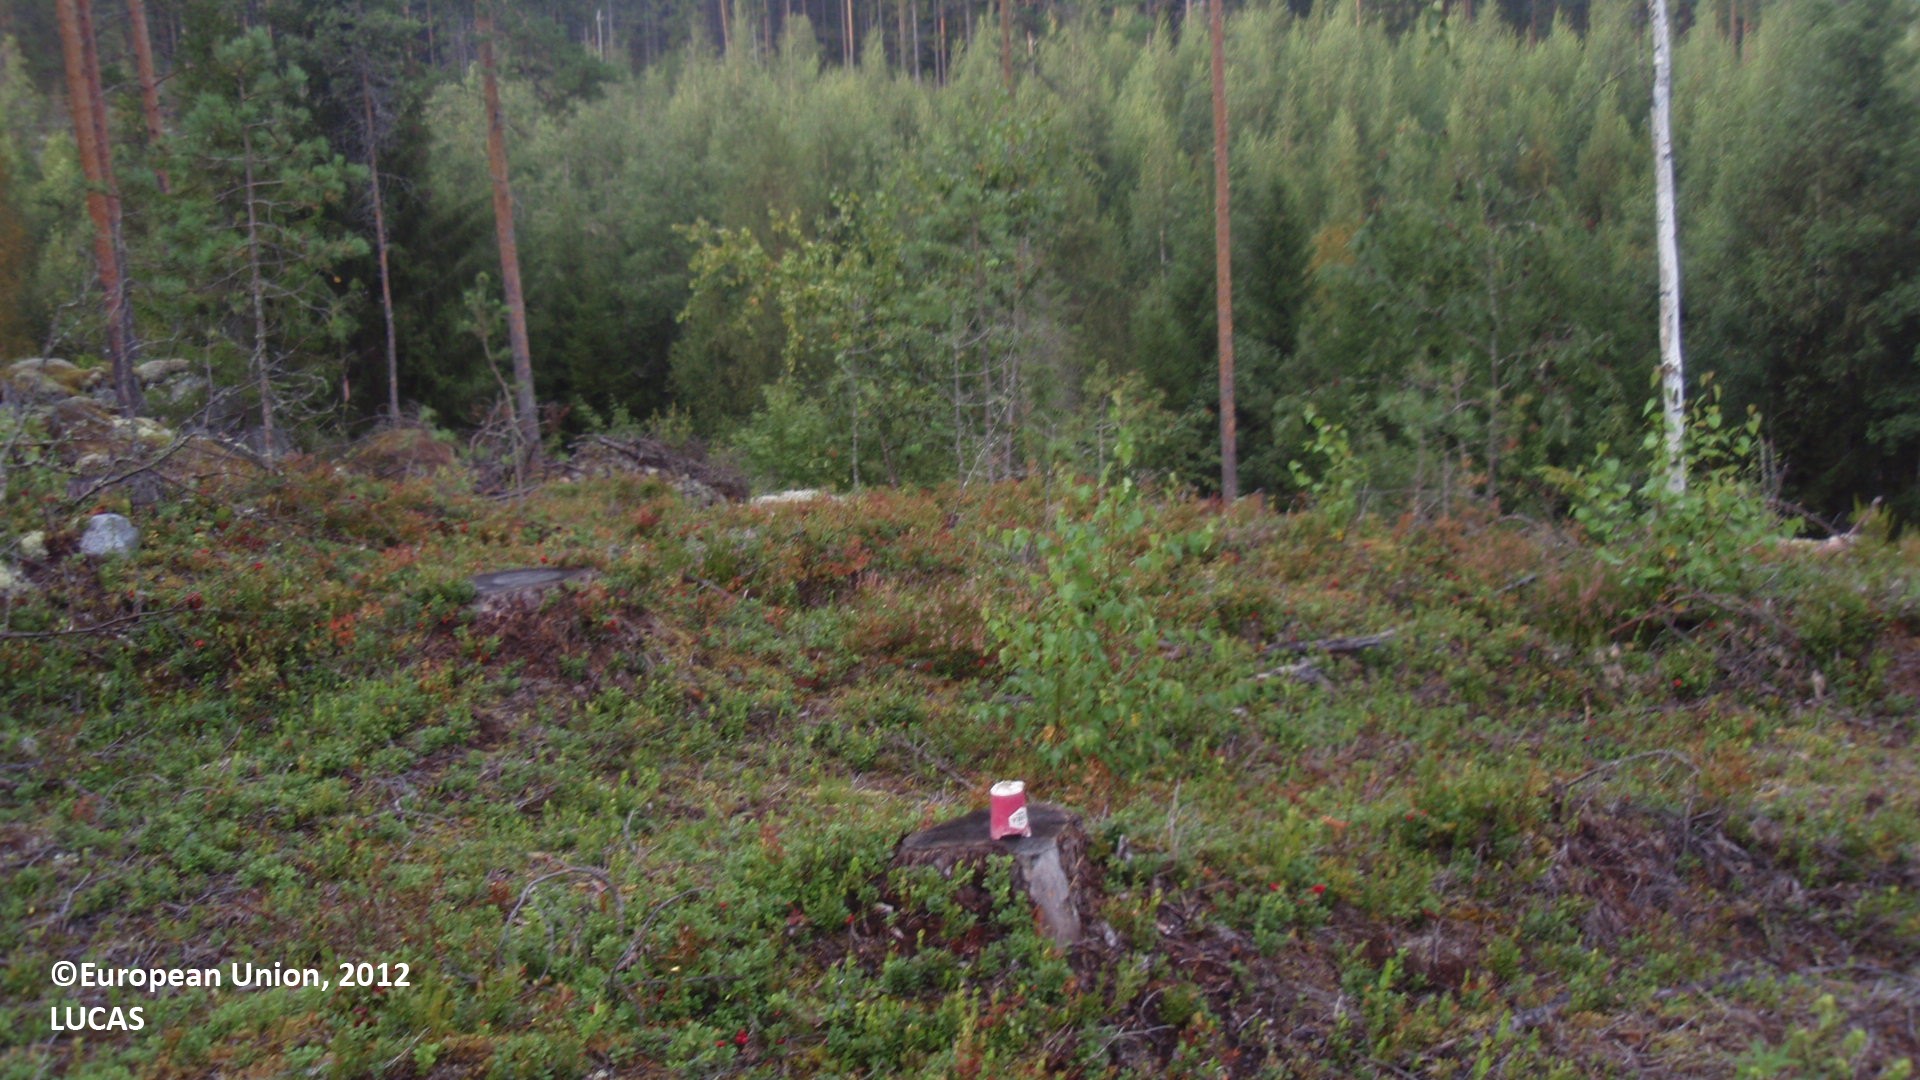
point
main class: Shrubland
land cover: Shrubland with sparse tree cover
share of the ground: > 75 %
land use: Forestry
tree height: > 5 m
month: August
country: FI
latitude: 61.5880
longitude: 27.8410
